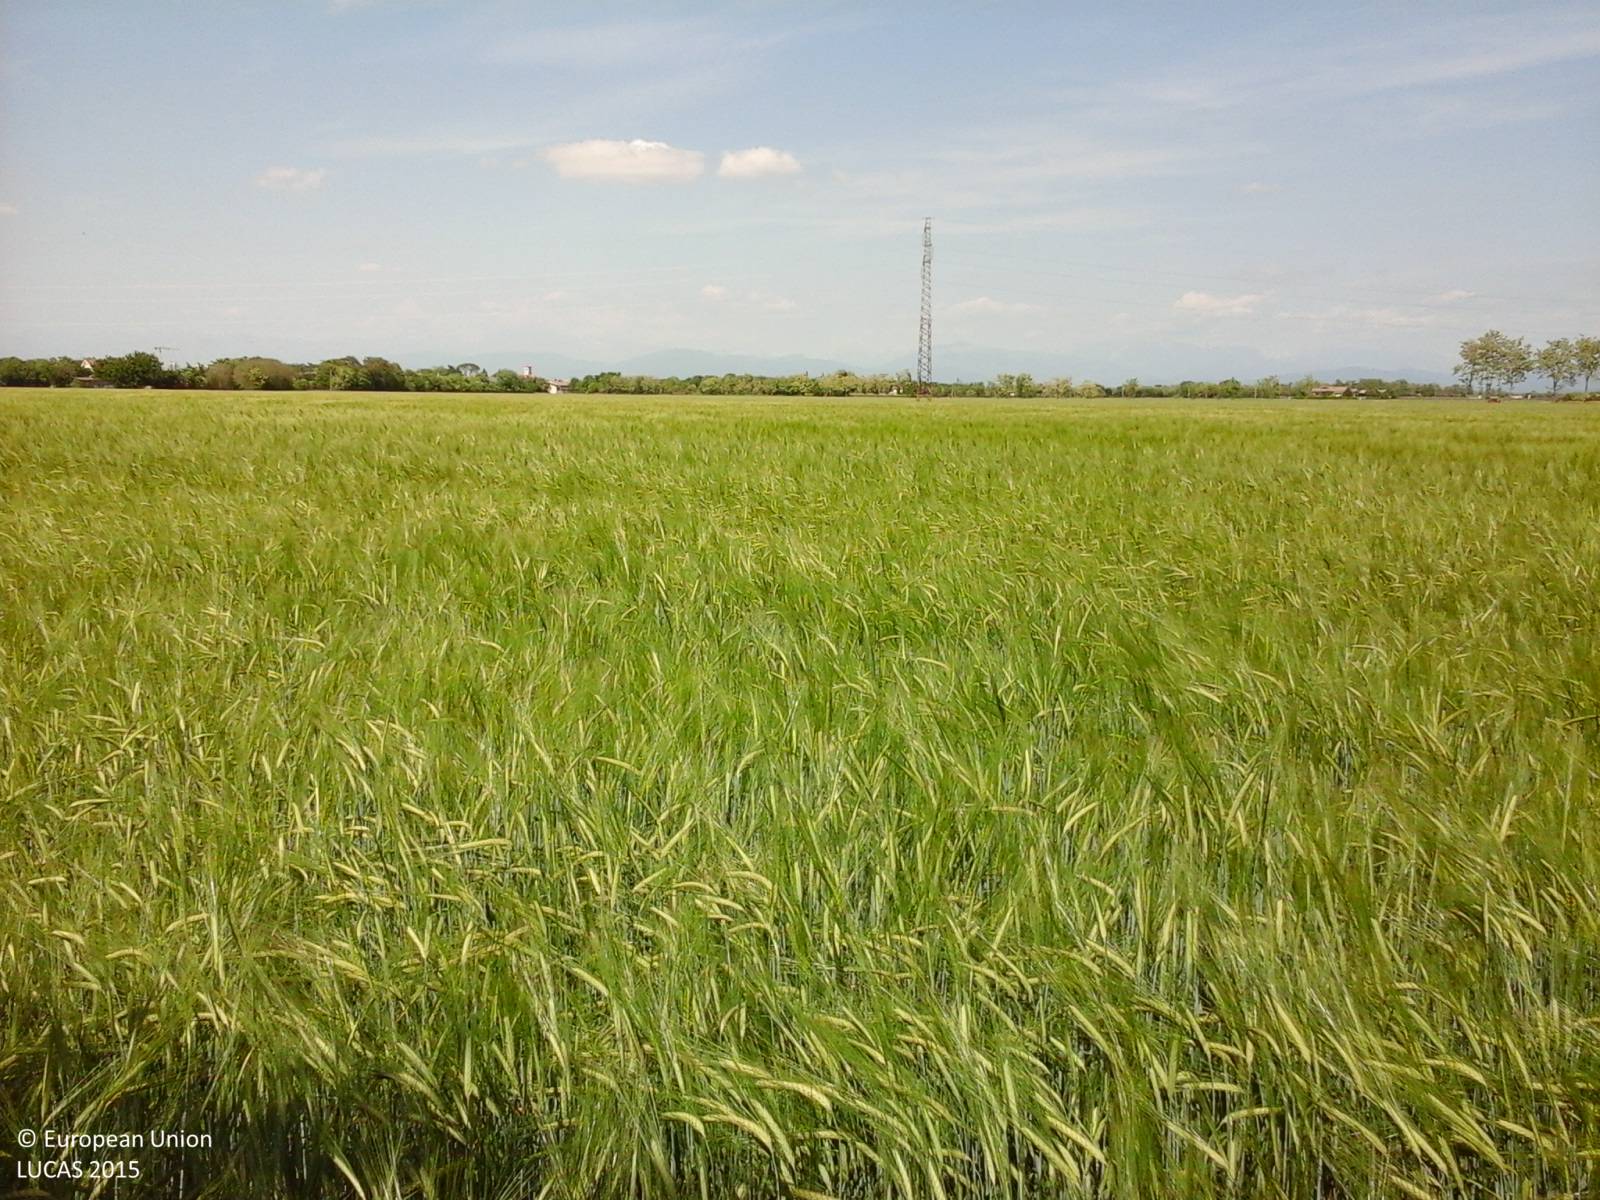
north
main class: Woodland
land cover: Broadleaved woodland
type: thermophilous deciduous forest
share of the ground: > 75 %
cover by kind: broadleaved forest trees 90 %, shrubs 10 %
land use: Forestry
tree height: > 5 m
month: May
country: IT
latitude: 45.9050
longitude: 13.2574
